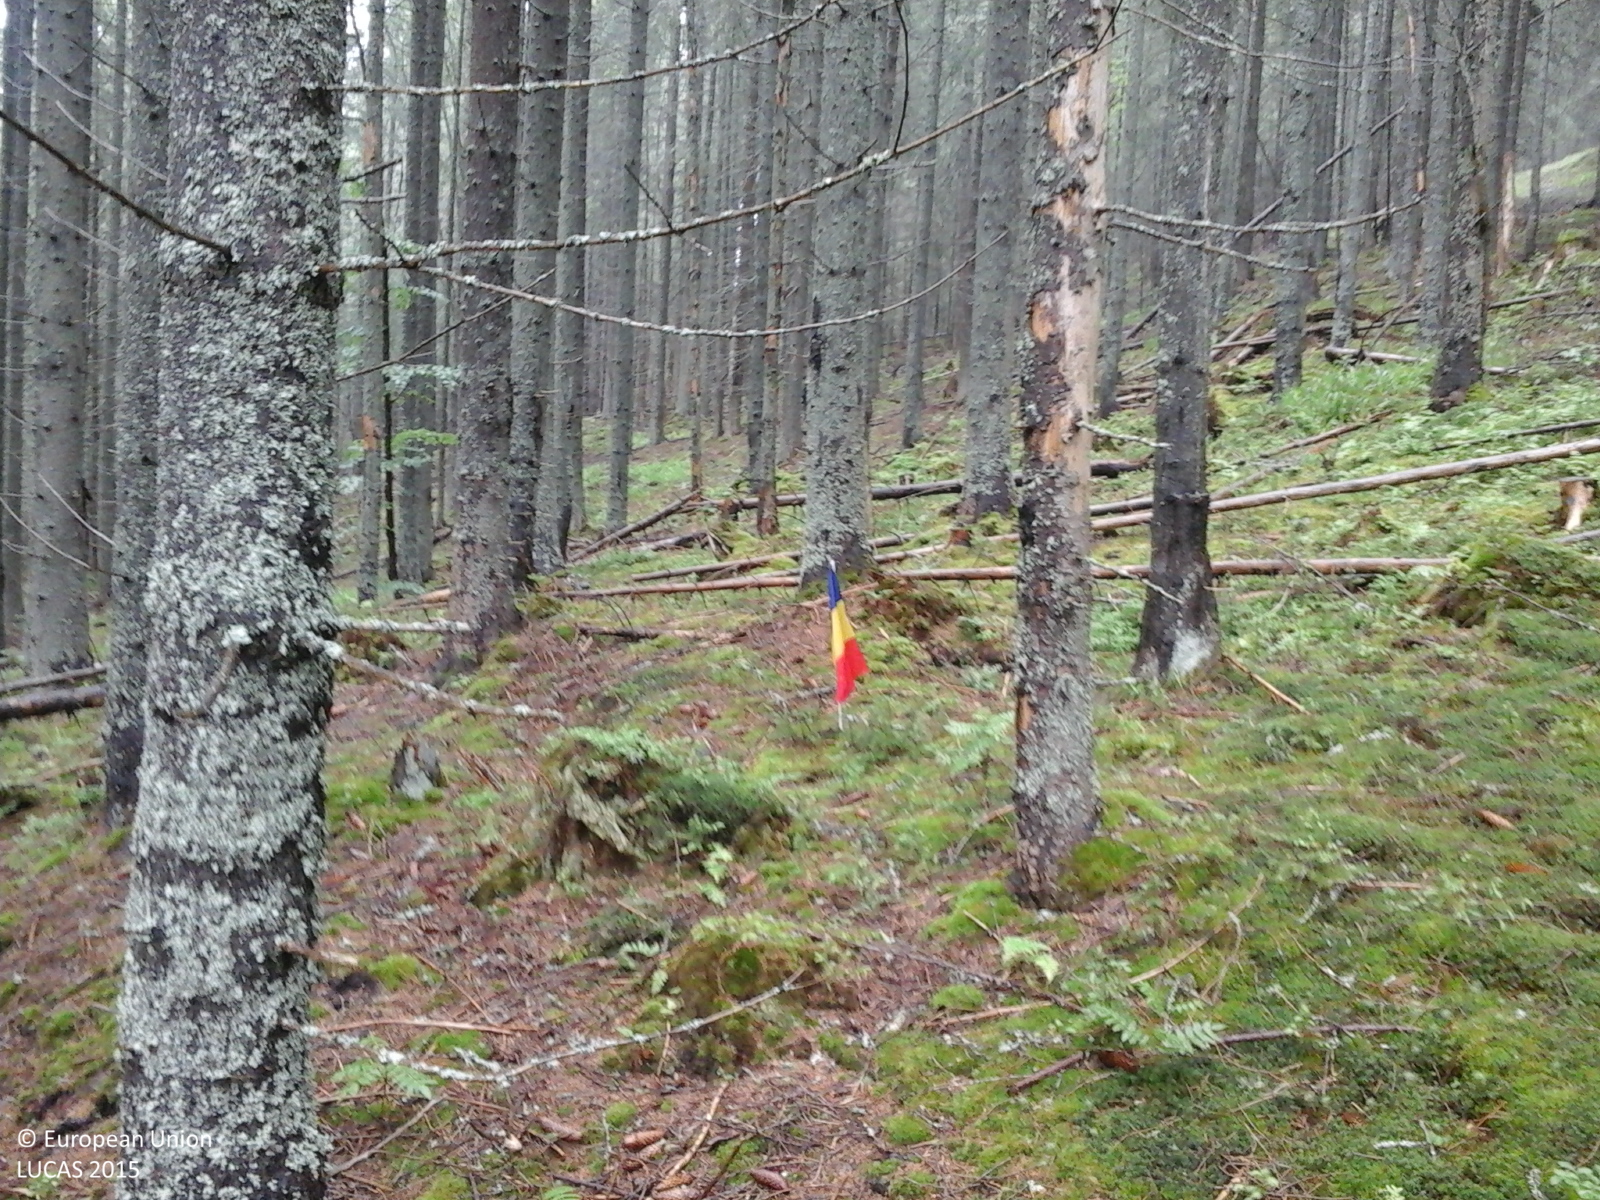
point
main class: Woodland
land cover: Spruce dominated coniferous woodland
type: alpine coniferous forest
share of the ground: > 75 %
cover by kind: coniferous forest trees 90 %, herbaceous plants 5 %, lichens and mosses 5 %
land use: Forestry
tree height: > 5 m
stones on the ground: 10 - 25 %
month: June
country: RO
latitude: 47.4162
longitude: 25.3407
